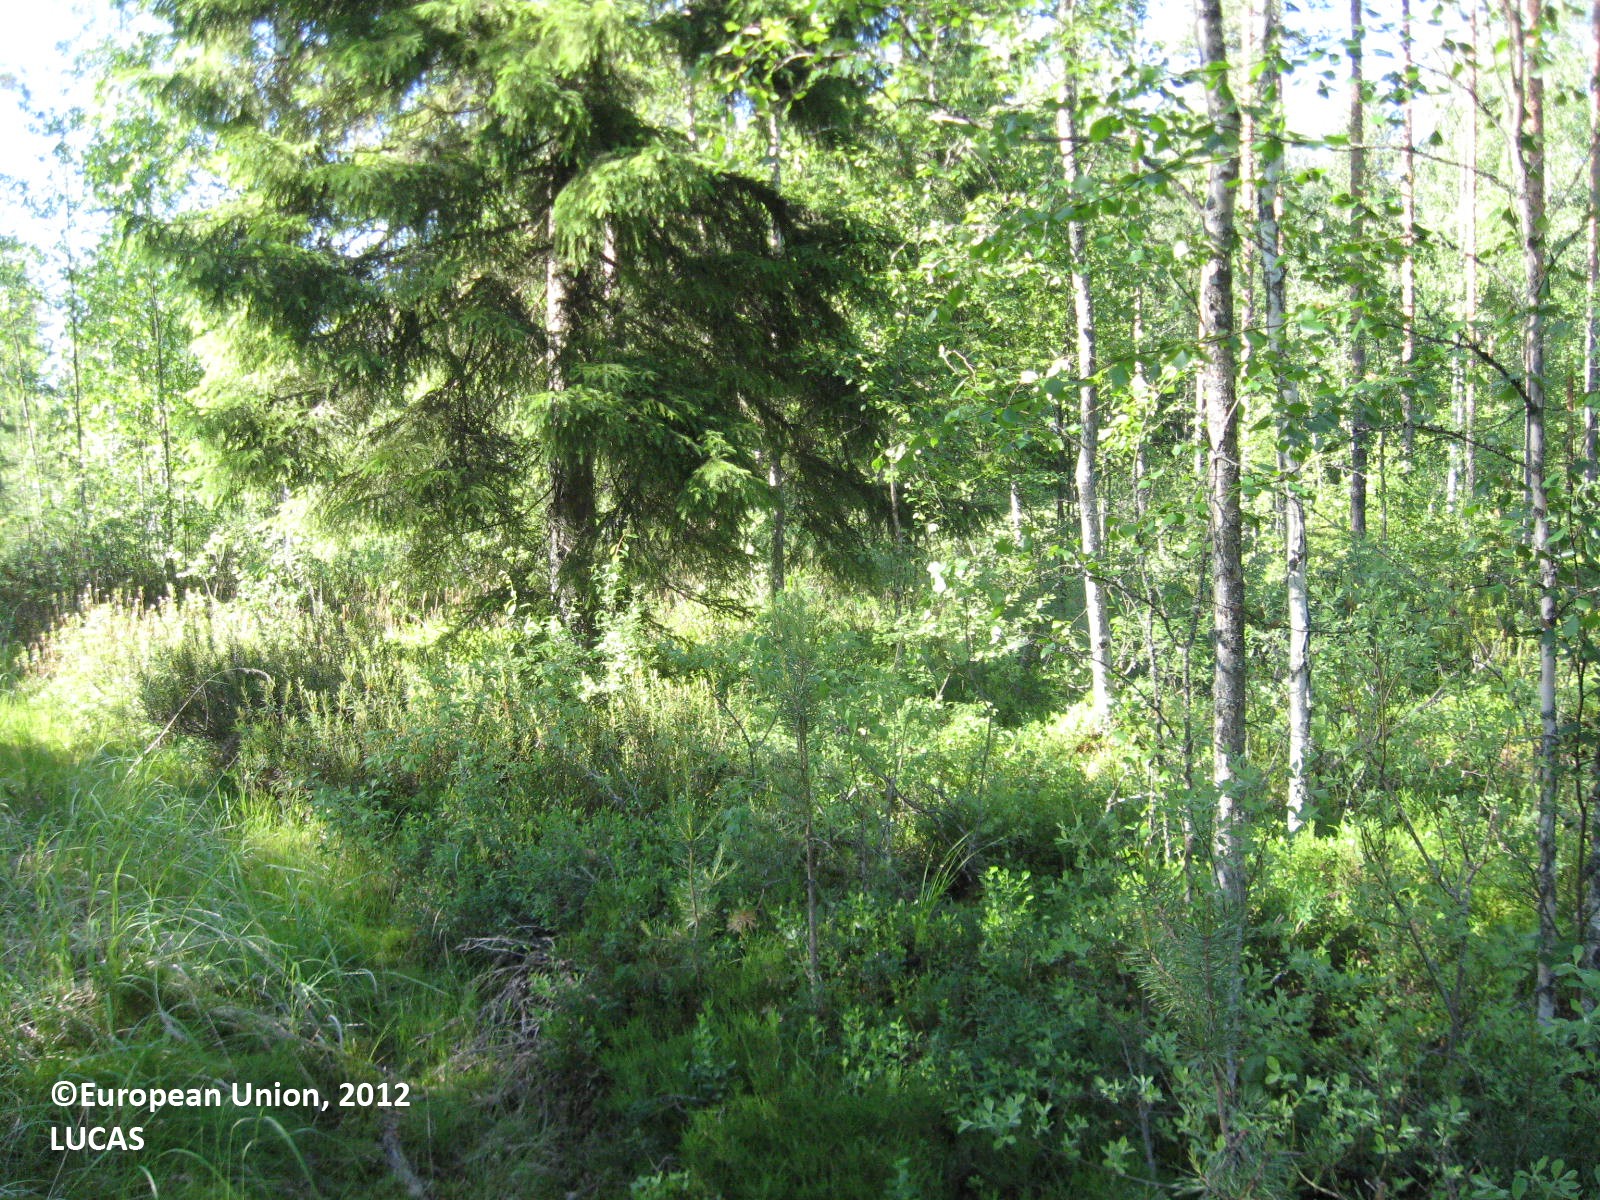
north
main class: Woodland
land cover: Other mixed woodland
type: boreal forest
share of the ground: > 75 %
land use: Forestry
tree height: > 5 m
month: July
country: FI
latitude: 62.6992
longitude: 22.8598
